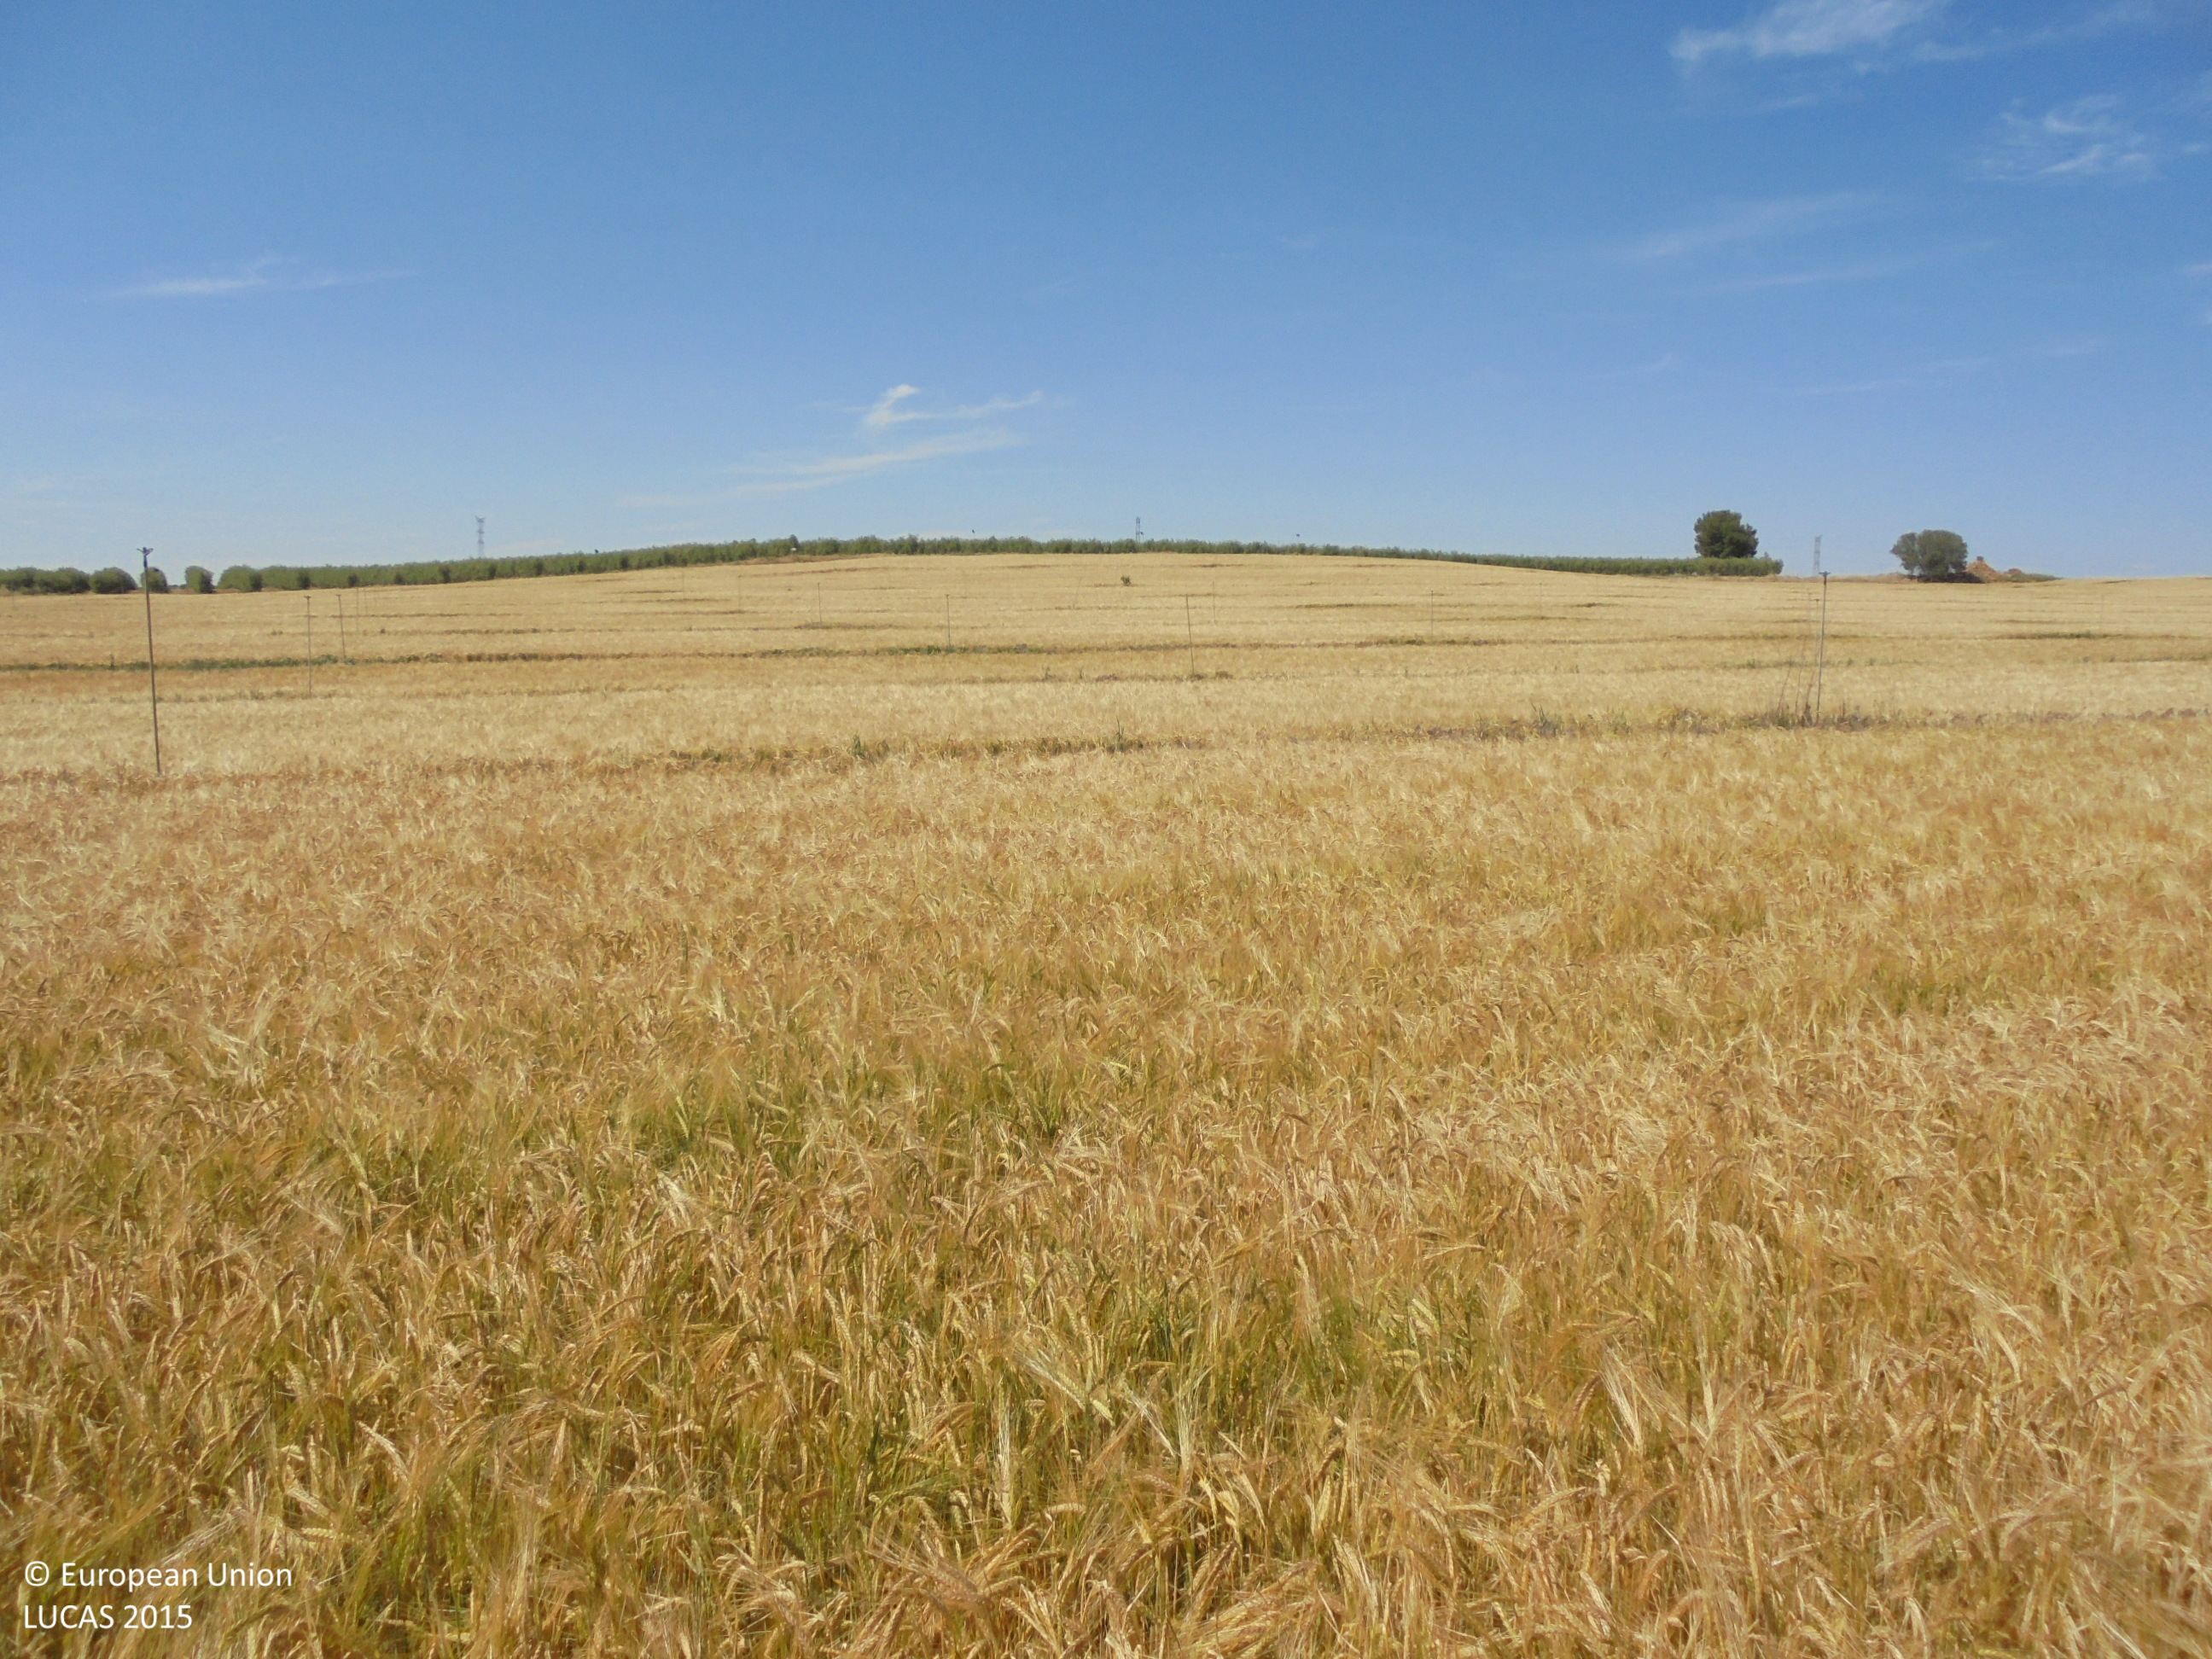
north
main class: Cropland
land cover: Barley
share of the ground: > 75 %
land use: Agriculture (excluding fallow land and kitchen gardens)
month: June
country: ES
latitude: 38.7593
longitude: -1.5609
